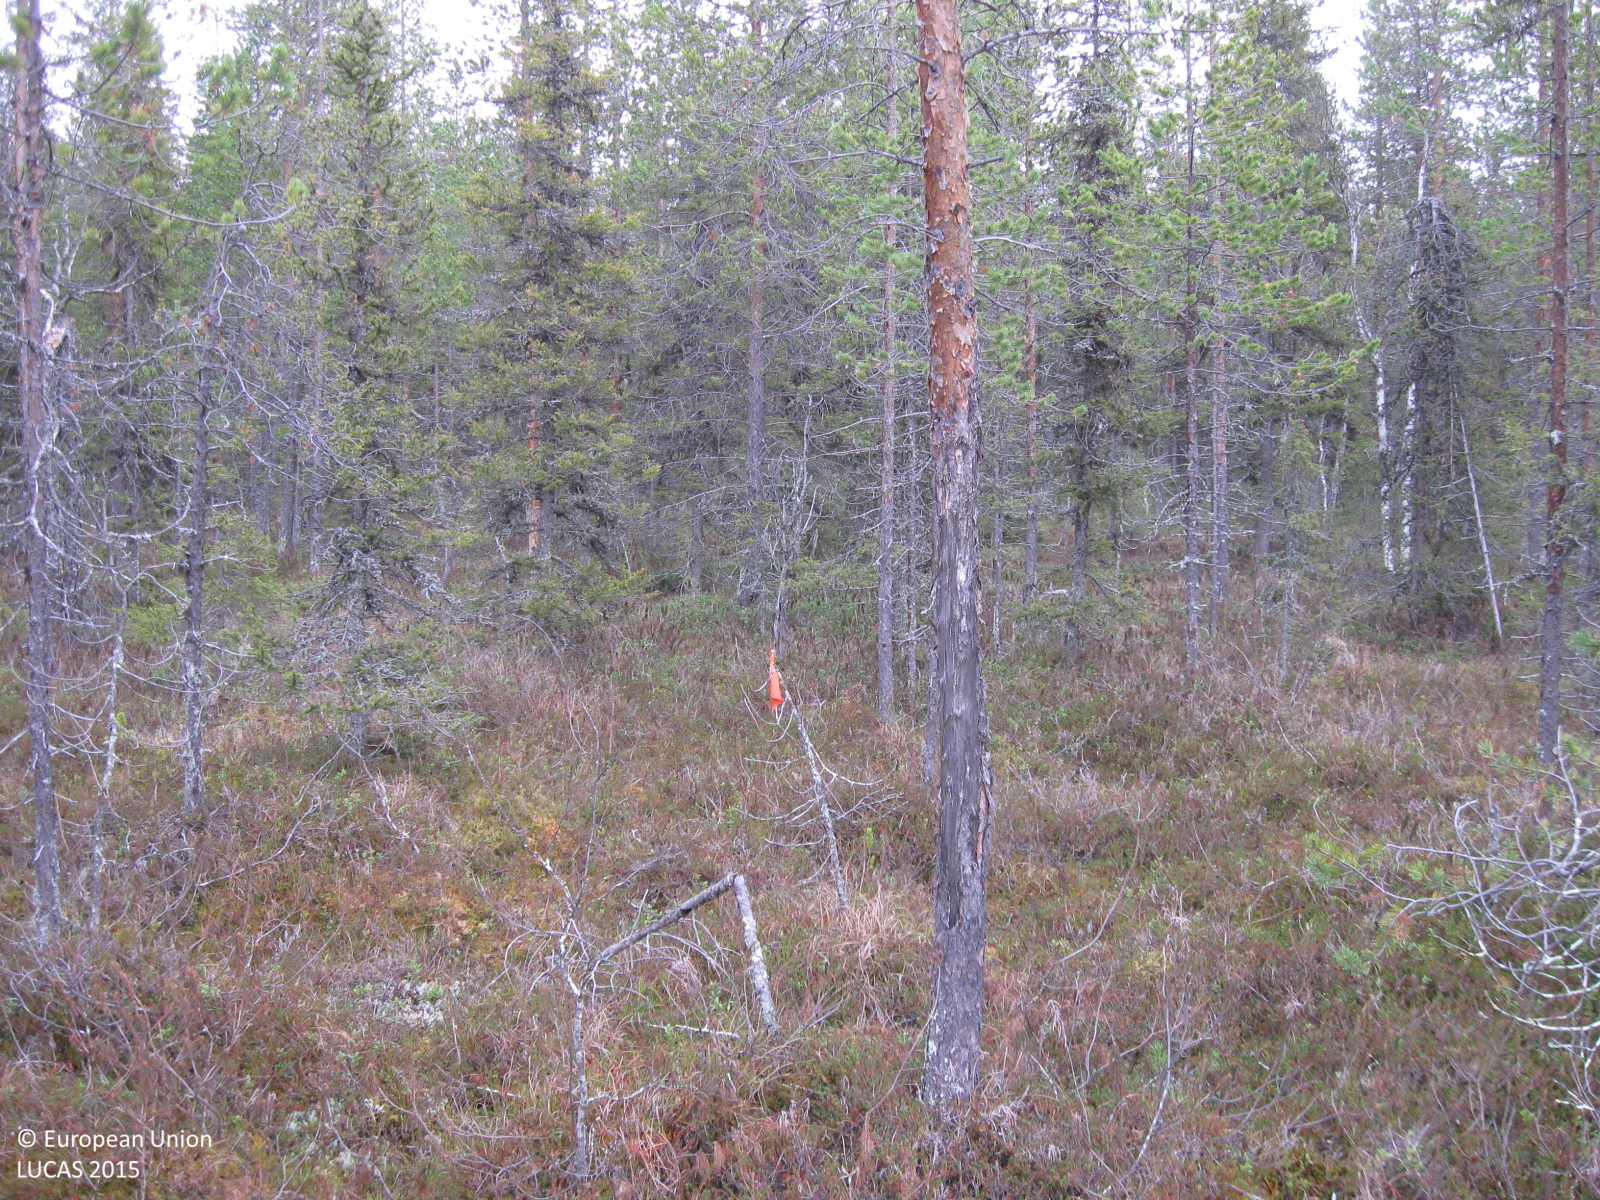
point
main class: Woodland
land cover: Pine dominated coniferous woodland
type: mire and swamp forests
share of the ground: 50 - 75 %
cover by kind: coniferous forest trees 70 %, shrubs 15 %, lichens and mosses 10 %, herbaceous plants 5 %
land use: Forestry
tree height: > 5 m
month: October
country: SE
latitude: 66.5915
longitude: 21.8517
